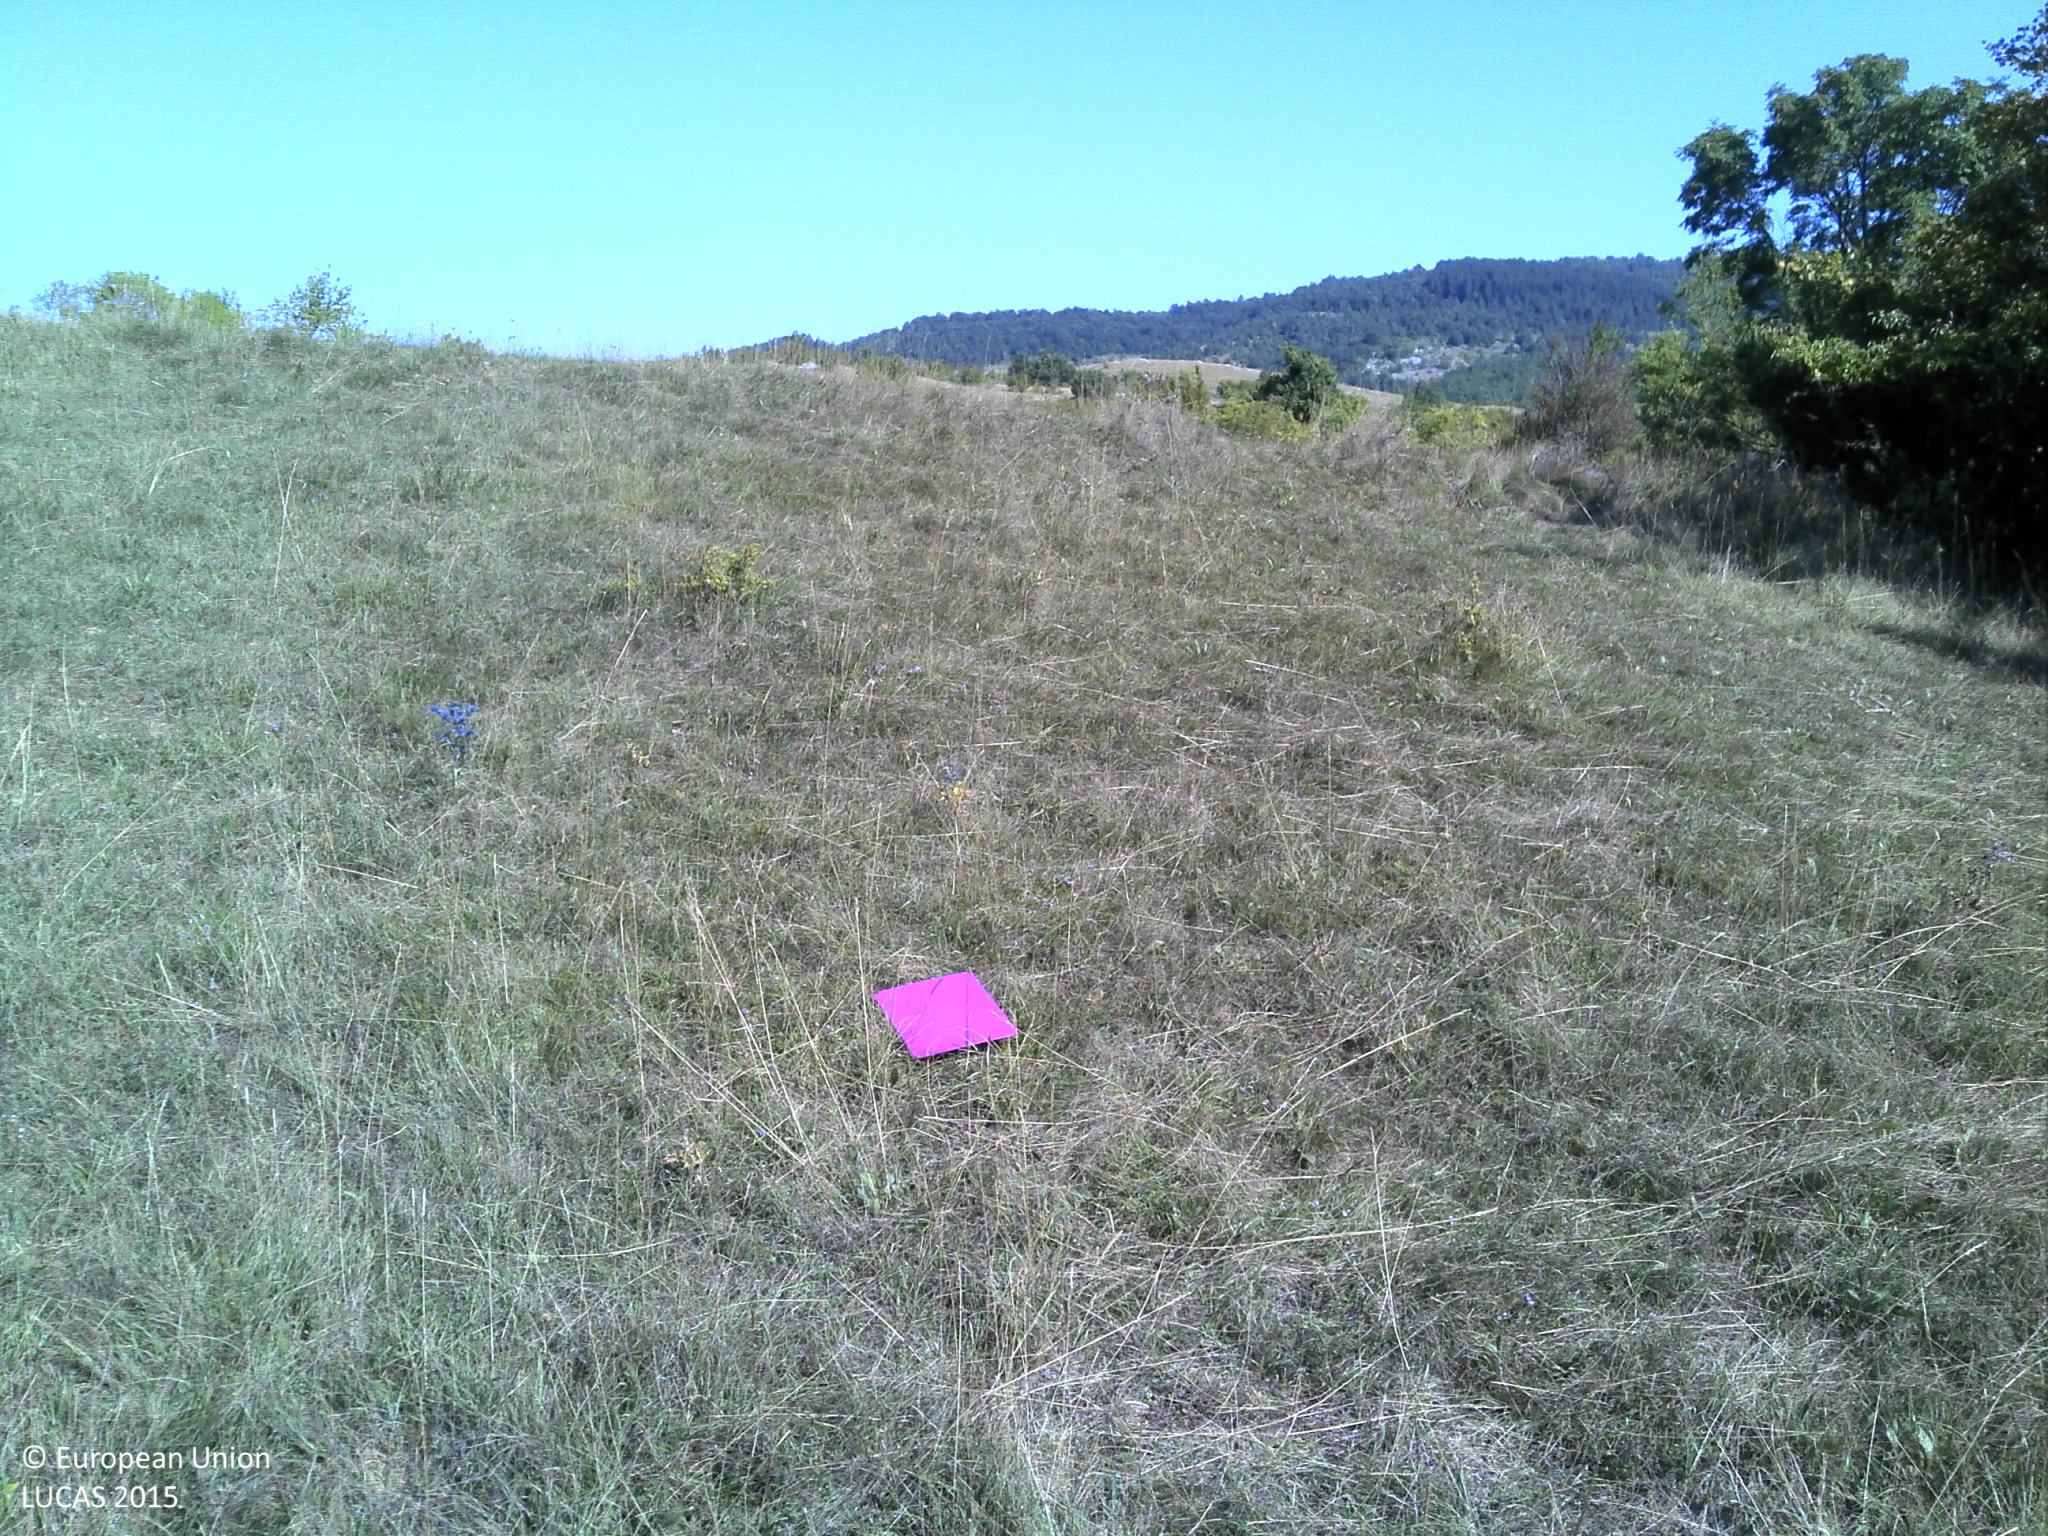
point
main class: Grassland
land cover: Grassland with sparse tree/shrub cover
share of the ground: > 75 %
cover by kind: herbaceous plants 90 %, broadleaved forest trees 5 %, shrubs 5 %
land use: Abandoned areas
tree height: < 5 m
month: September
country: HR
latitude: 44.3661
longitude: 15.8533
